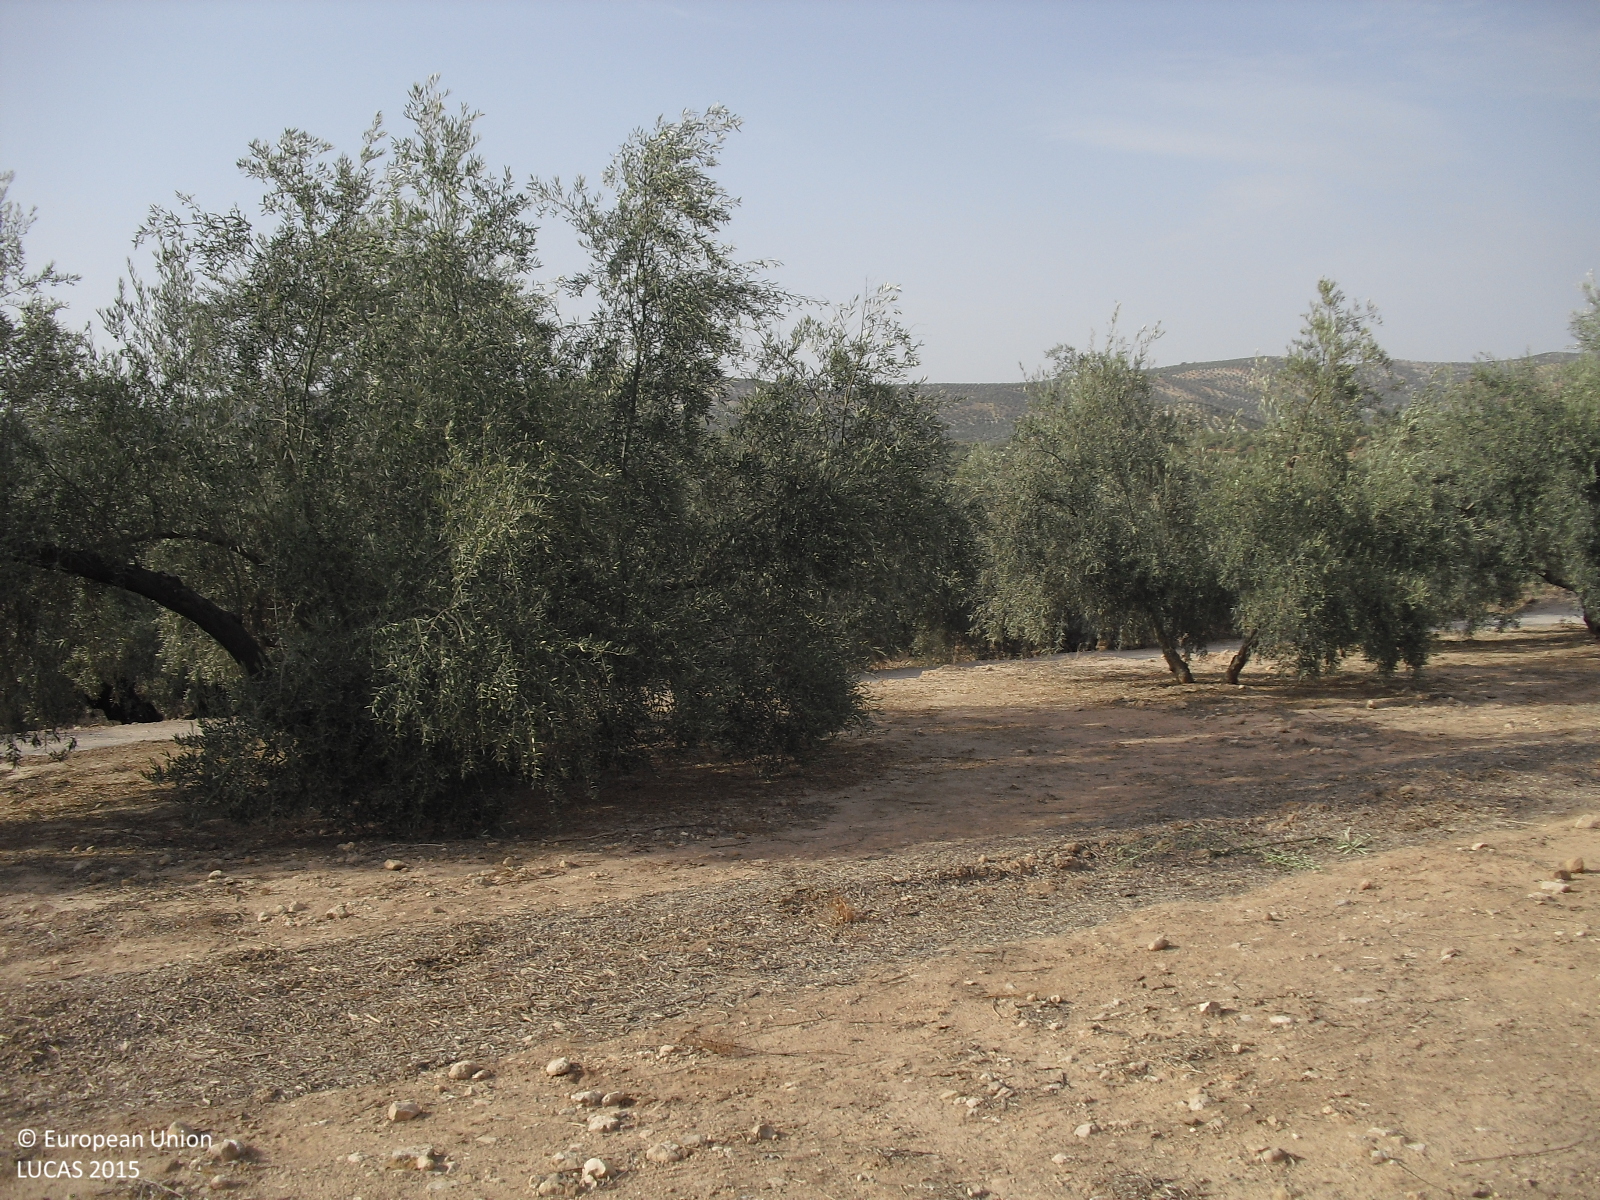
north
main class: Cropland
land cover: Olive groves
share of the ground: 25 - 50 %
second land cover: Other bare soil
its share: > 75 %
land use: Agriculture (excluding fallow land and kitchen gardens)
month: August
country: ES
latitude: 37.2637
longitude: -4.4443
